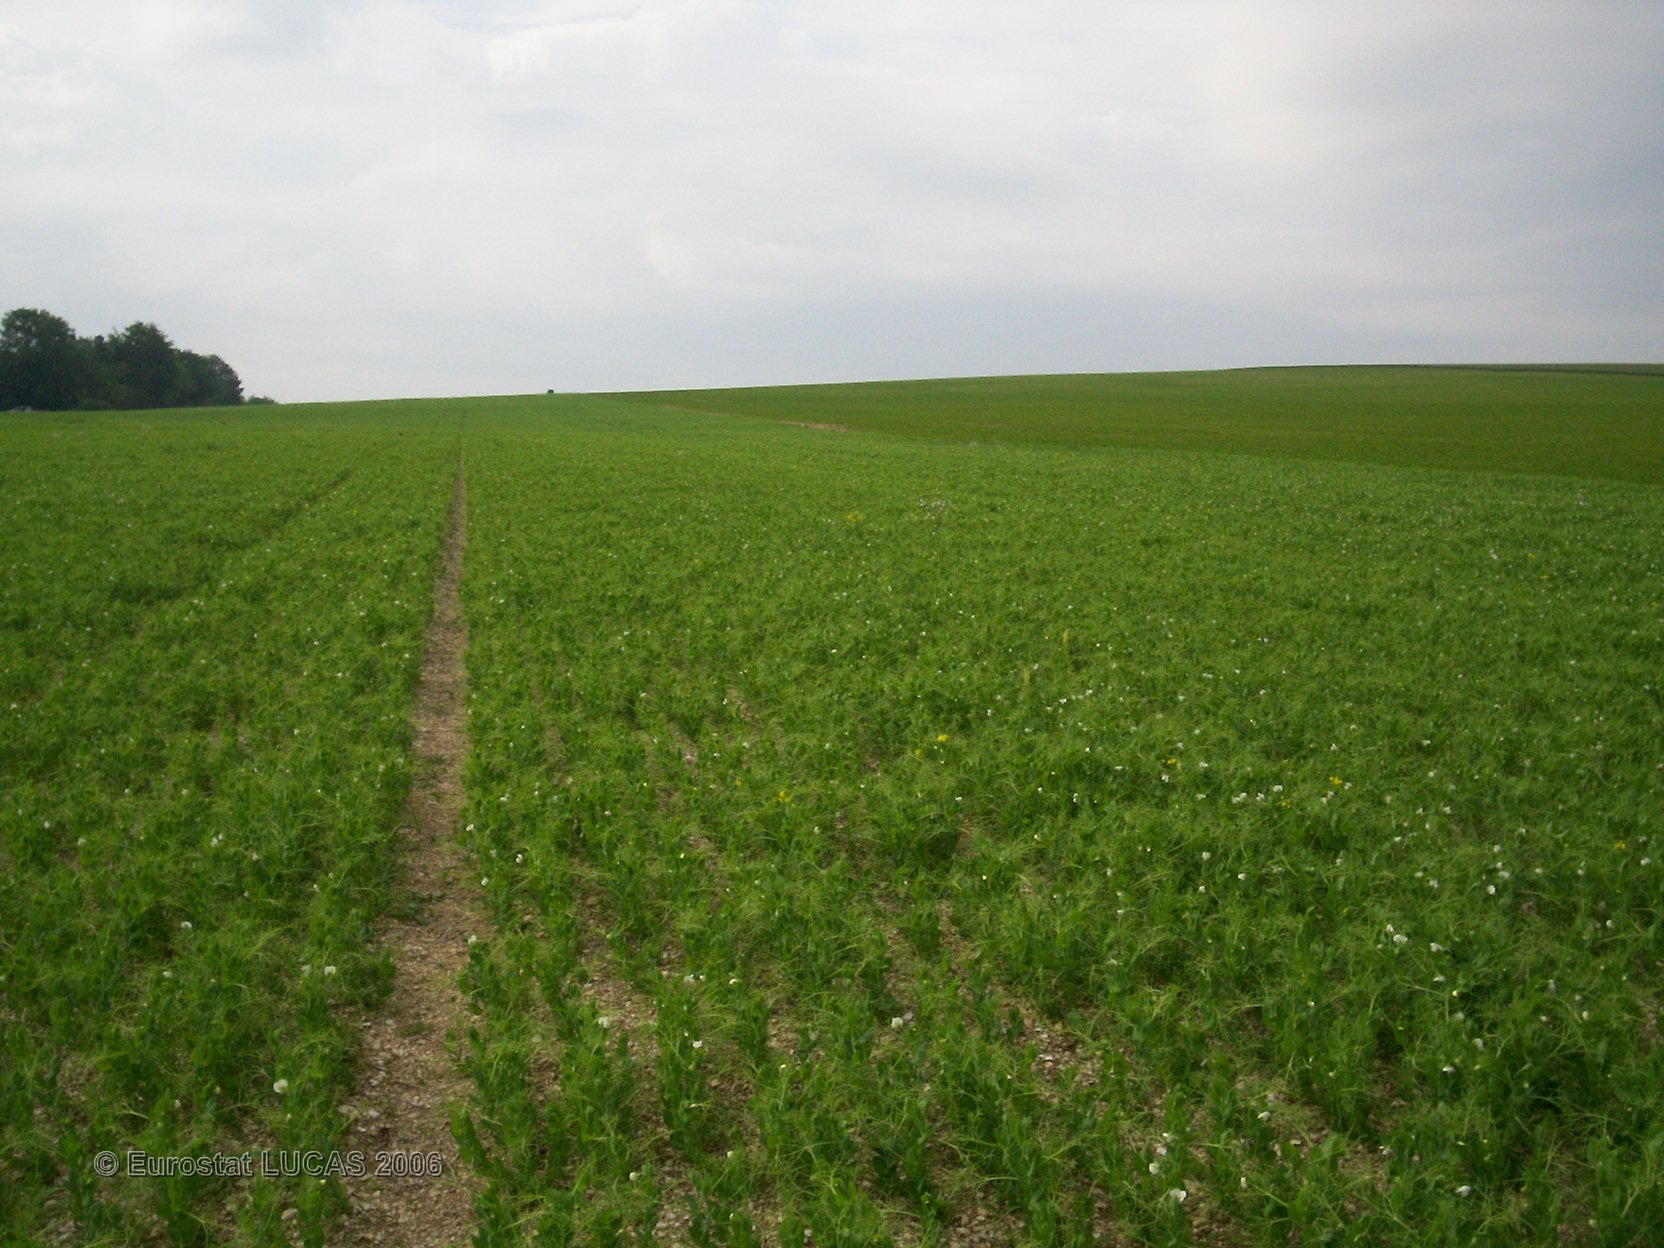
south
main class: Cropland
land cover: Dry pulses
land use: Agriculture (excluding fallow land and kitchen gardens)
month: June
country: FR
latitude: 48.7350
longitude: 4.4902
